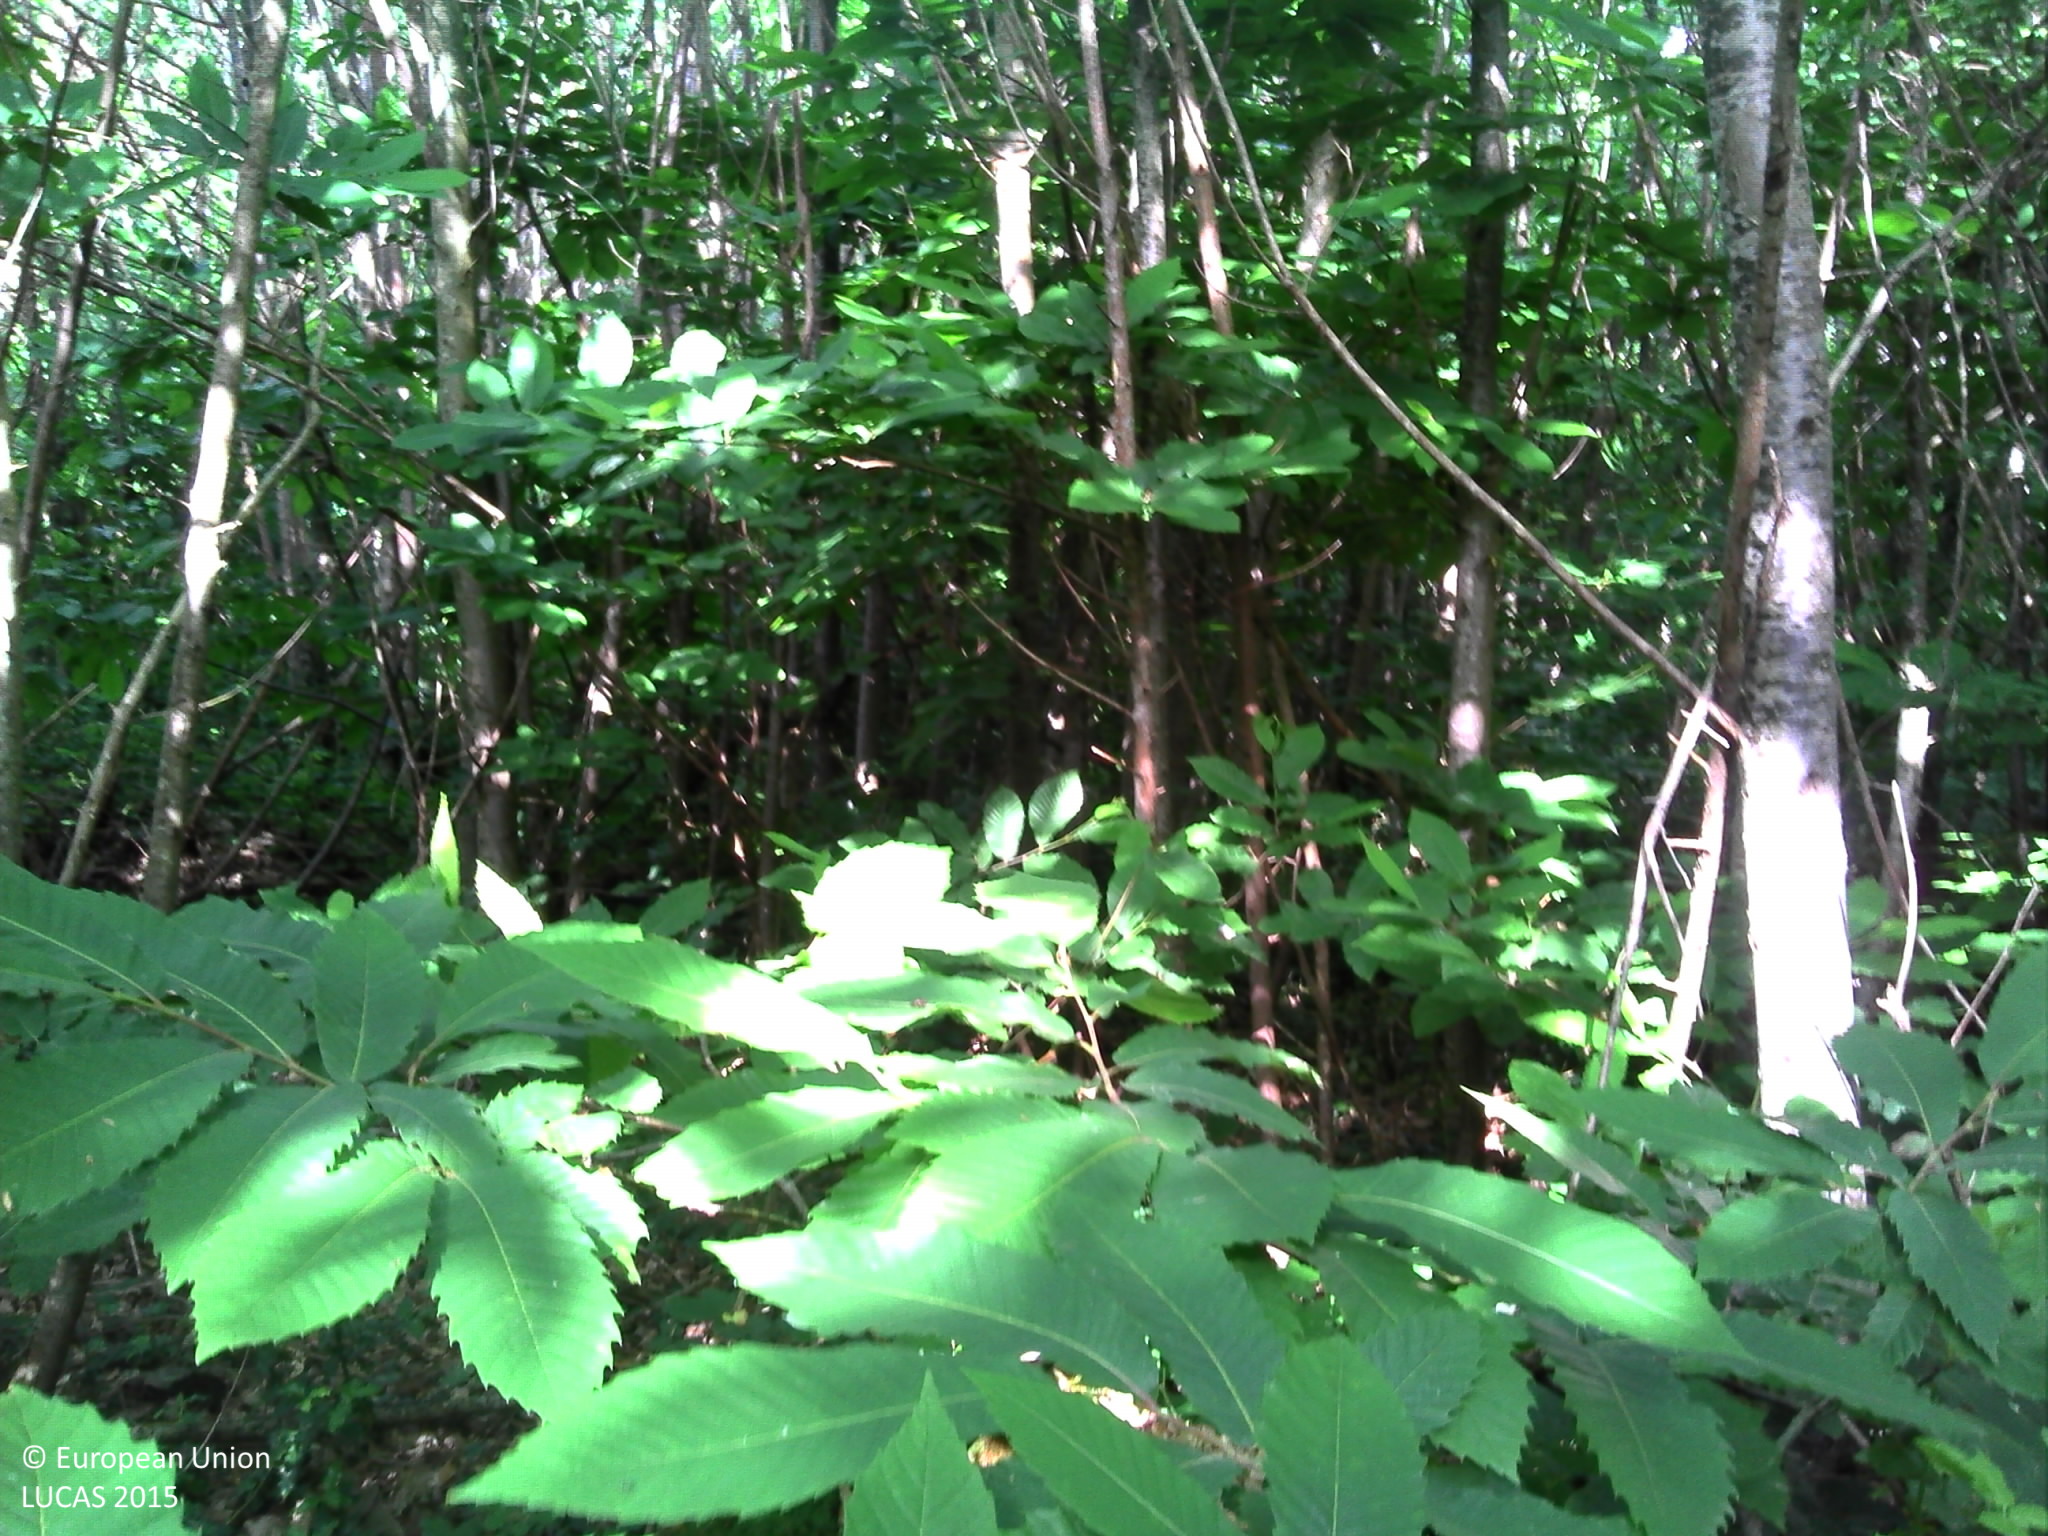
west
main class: Woodland
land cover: Broadleaved woodland
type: mesophytic deciduous forest
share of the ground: > 75 %
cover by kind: broadleaved forest trees 95 %, herbaceous plants 5 %
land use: Forestry
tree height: > 5 m
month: June
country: FR
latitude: 47.2072
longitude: -1.2736
